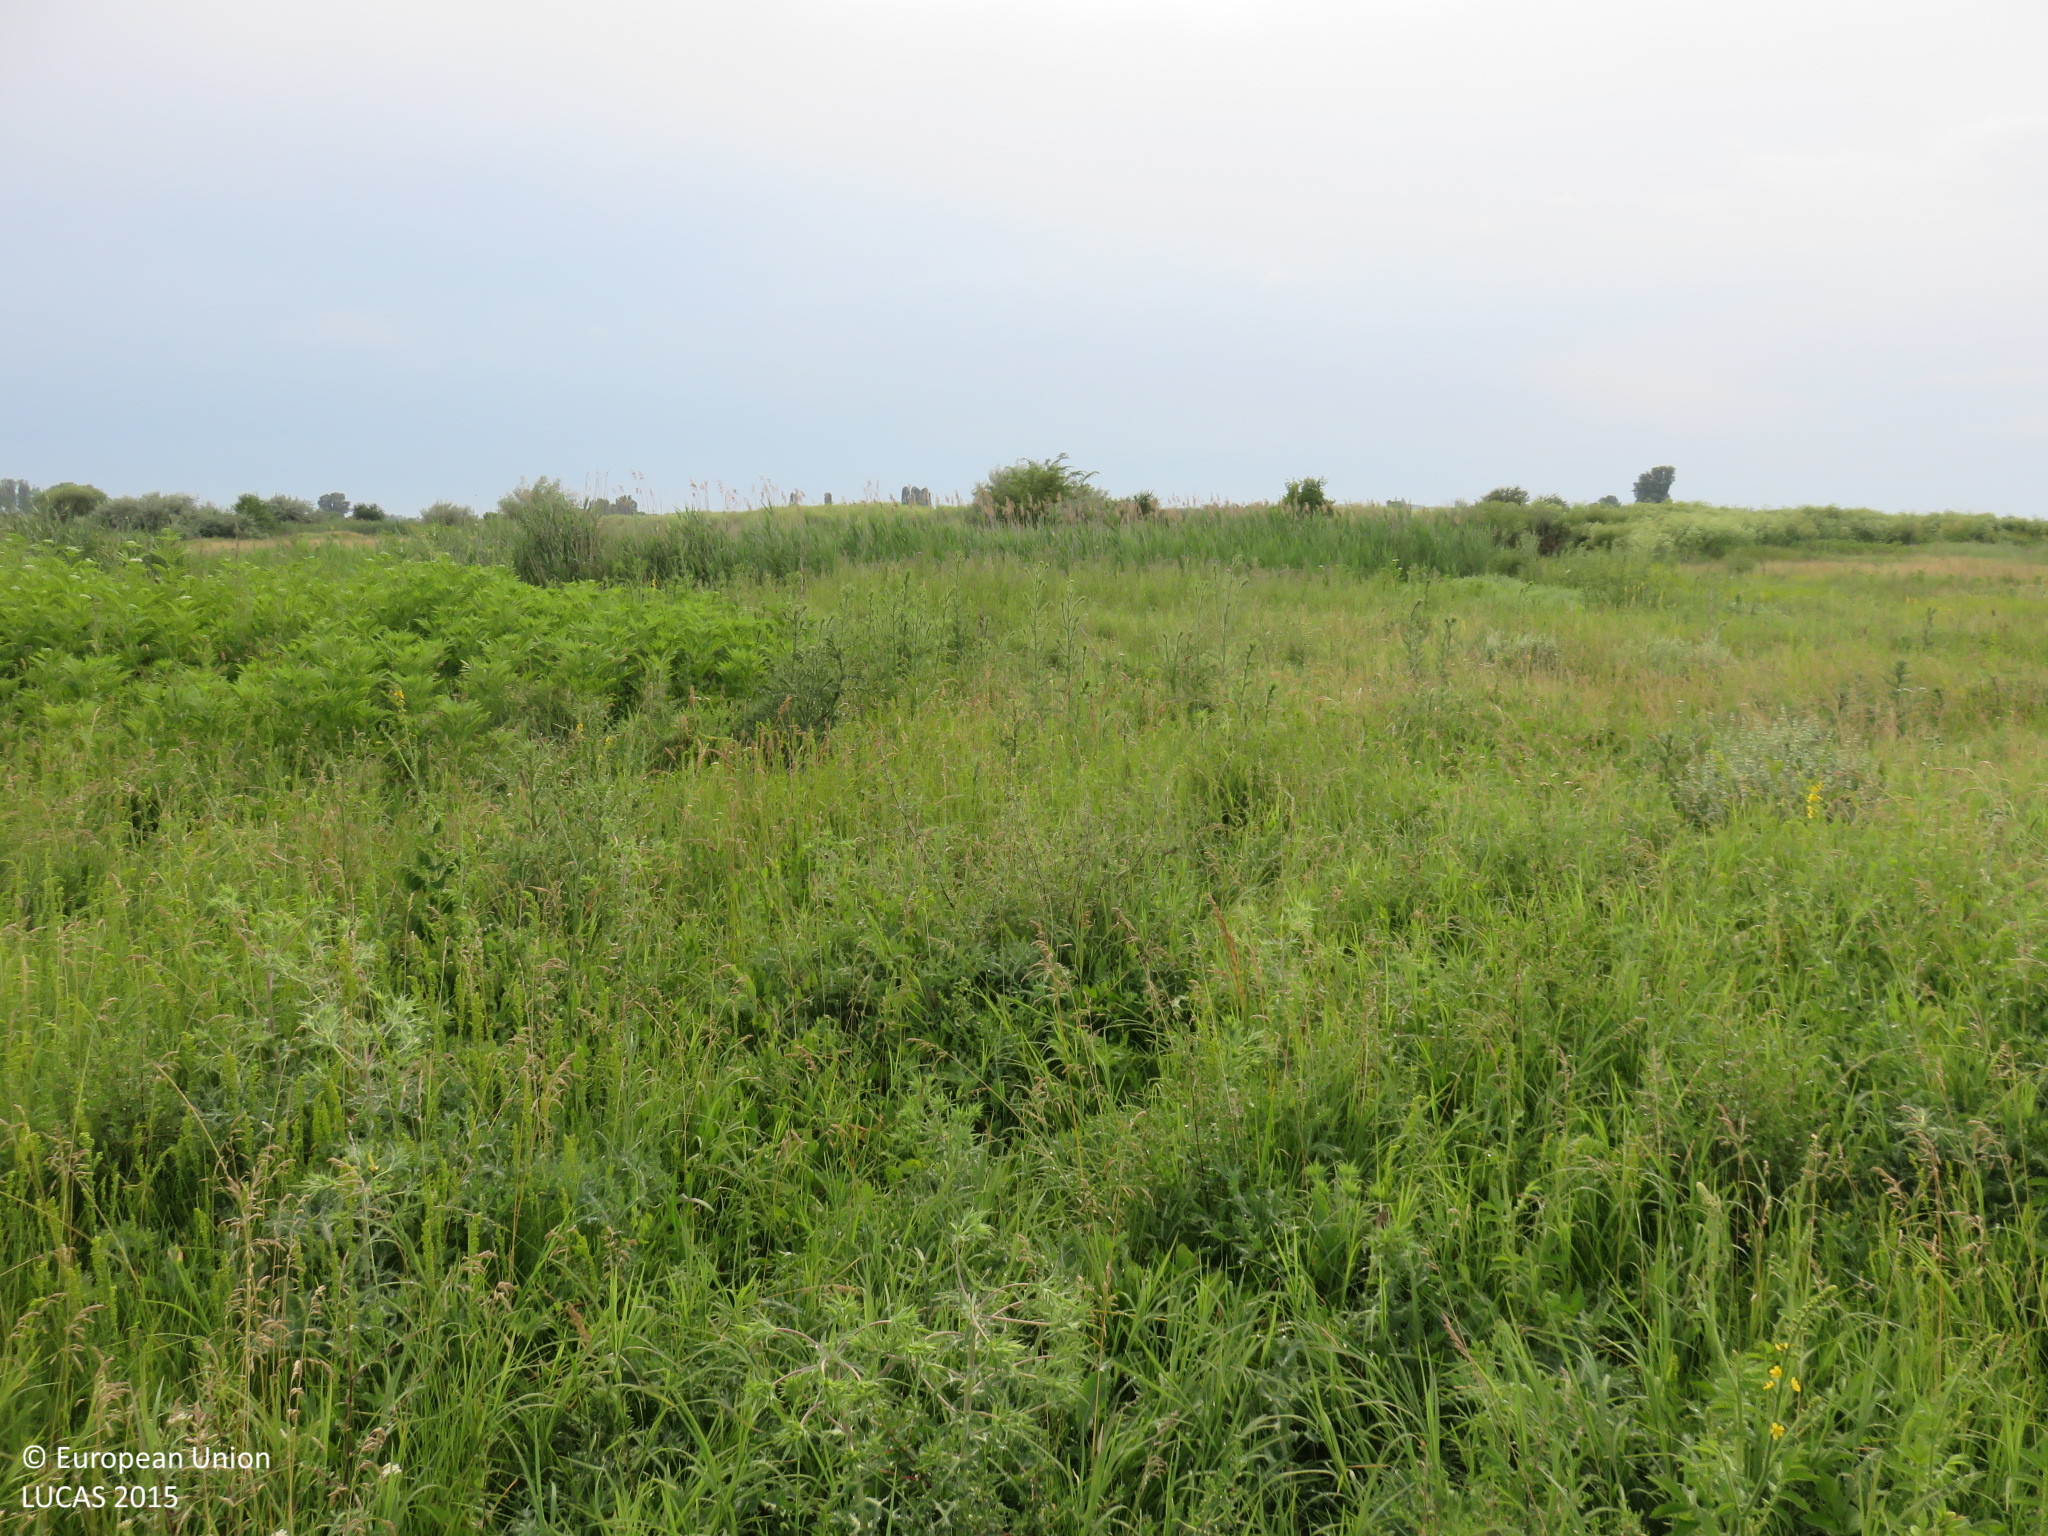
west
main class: Grassland
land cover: Grassland without tree/shrub cover
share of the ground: > 75 %
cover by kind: herbaceous plants 100 %
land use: Semi-natural and natural areas not in use
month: June
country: BG
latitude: 43.4140
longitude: 24.5230
